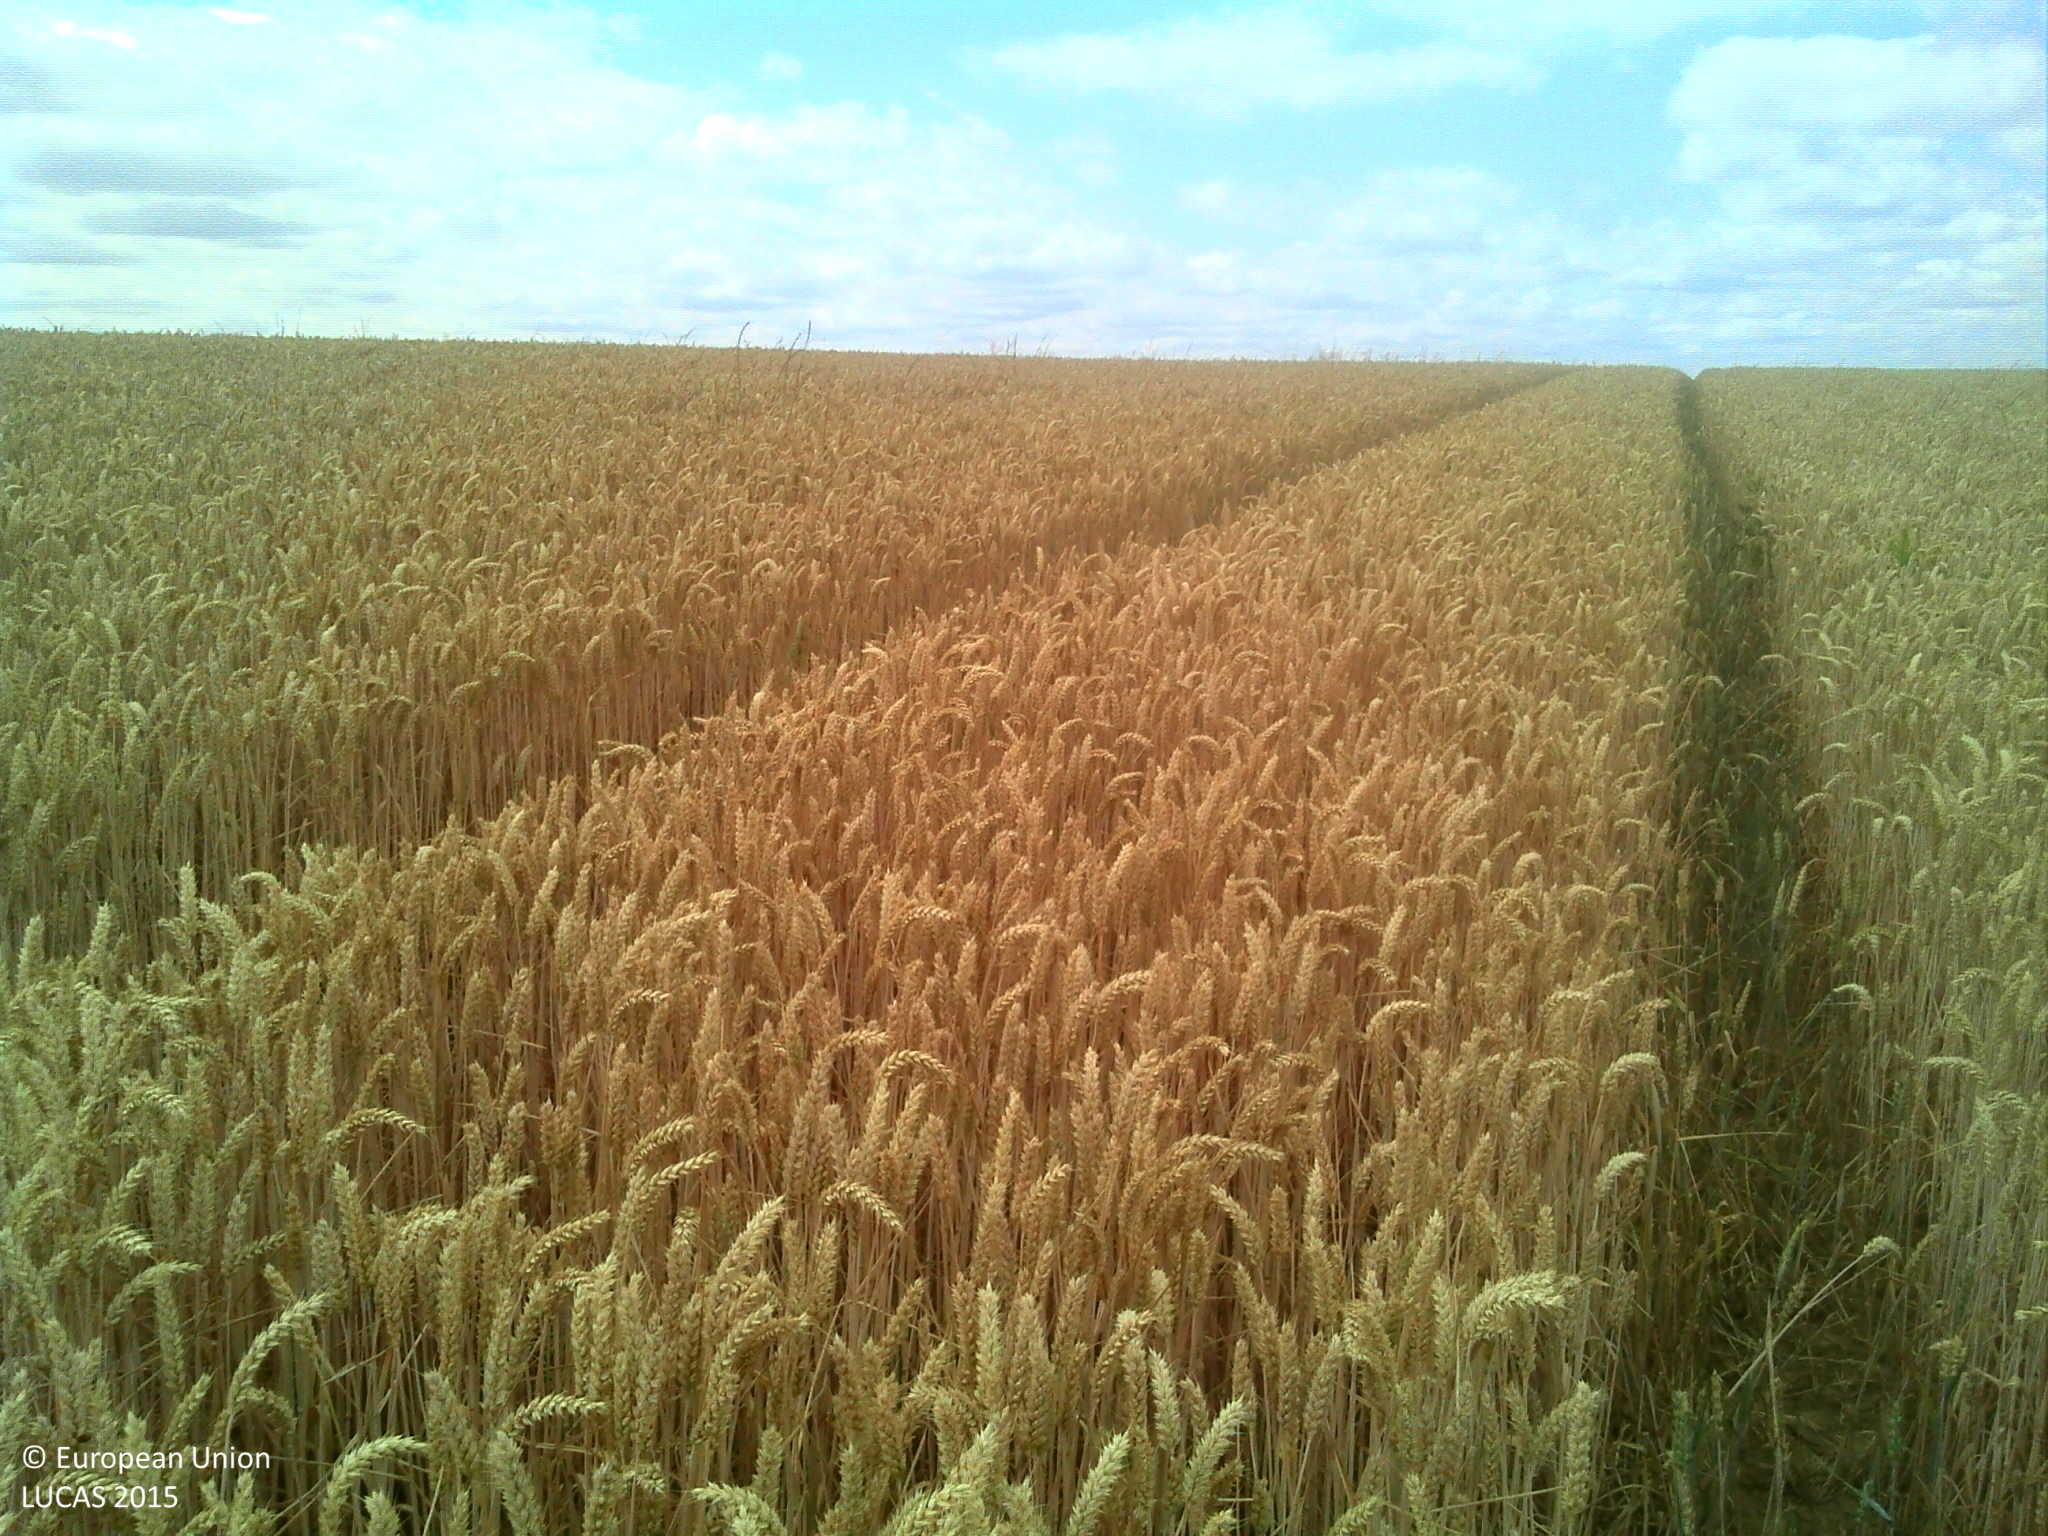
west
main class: Cropland
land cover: Common wheat
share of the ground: > 75 %
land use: Agriculture (excluding fallow land and kitchen gardens)
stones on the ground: < 10 %
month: July
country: FR
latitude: 49.2278
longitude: 3.2773
